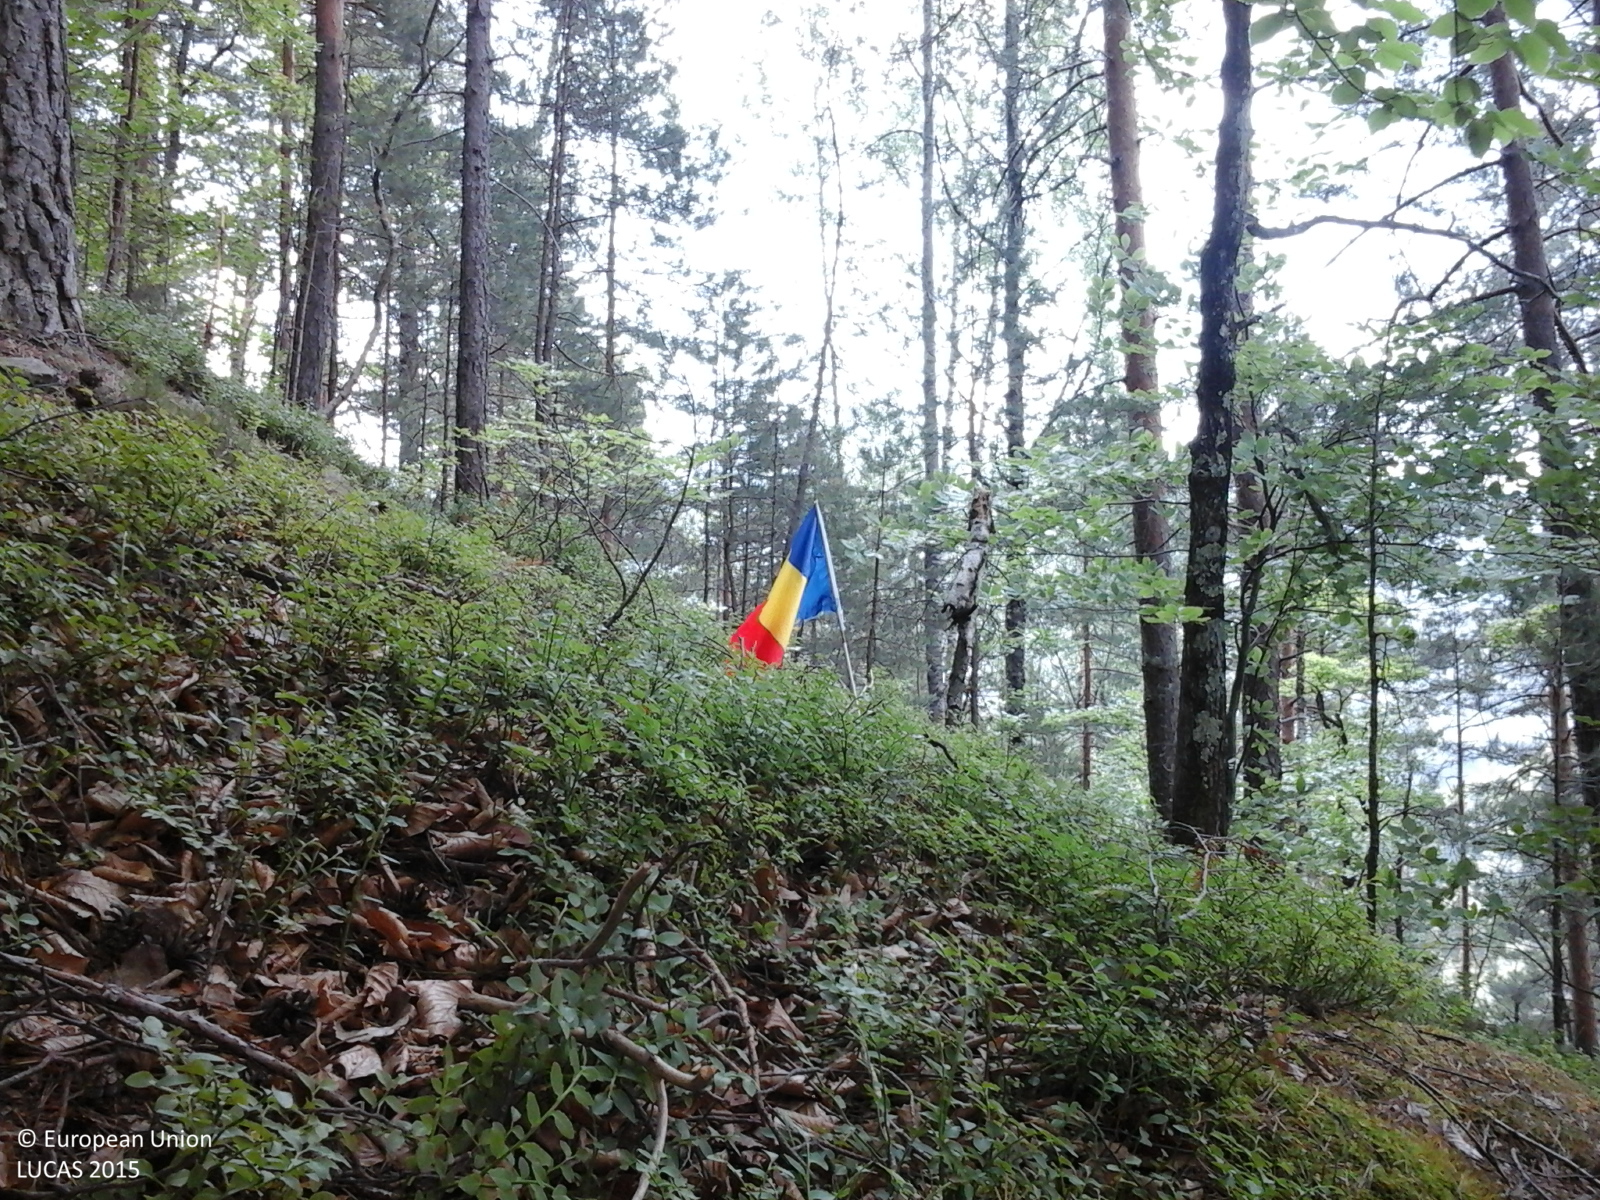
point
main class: Woodland
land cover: Pine dominated mixed woodland
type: alpine coniferous forest
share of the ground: > 75 %
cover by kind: coniferous forest trees 75 %, broadleaved forest trees 25 %
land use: Forestry
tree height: > 5 m
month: June
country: RO
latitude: 46.2620
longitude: 26.4386
